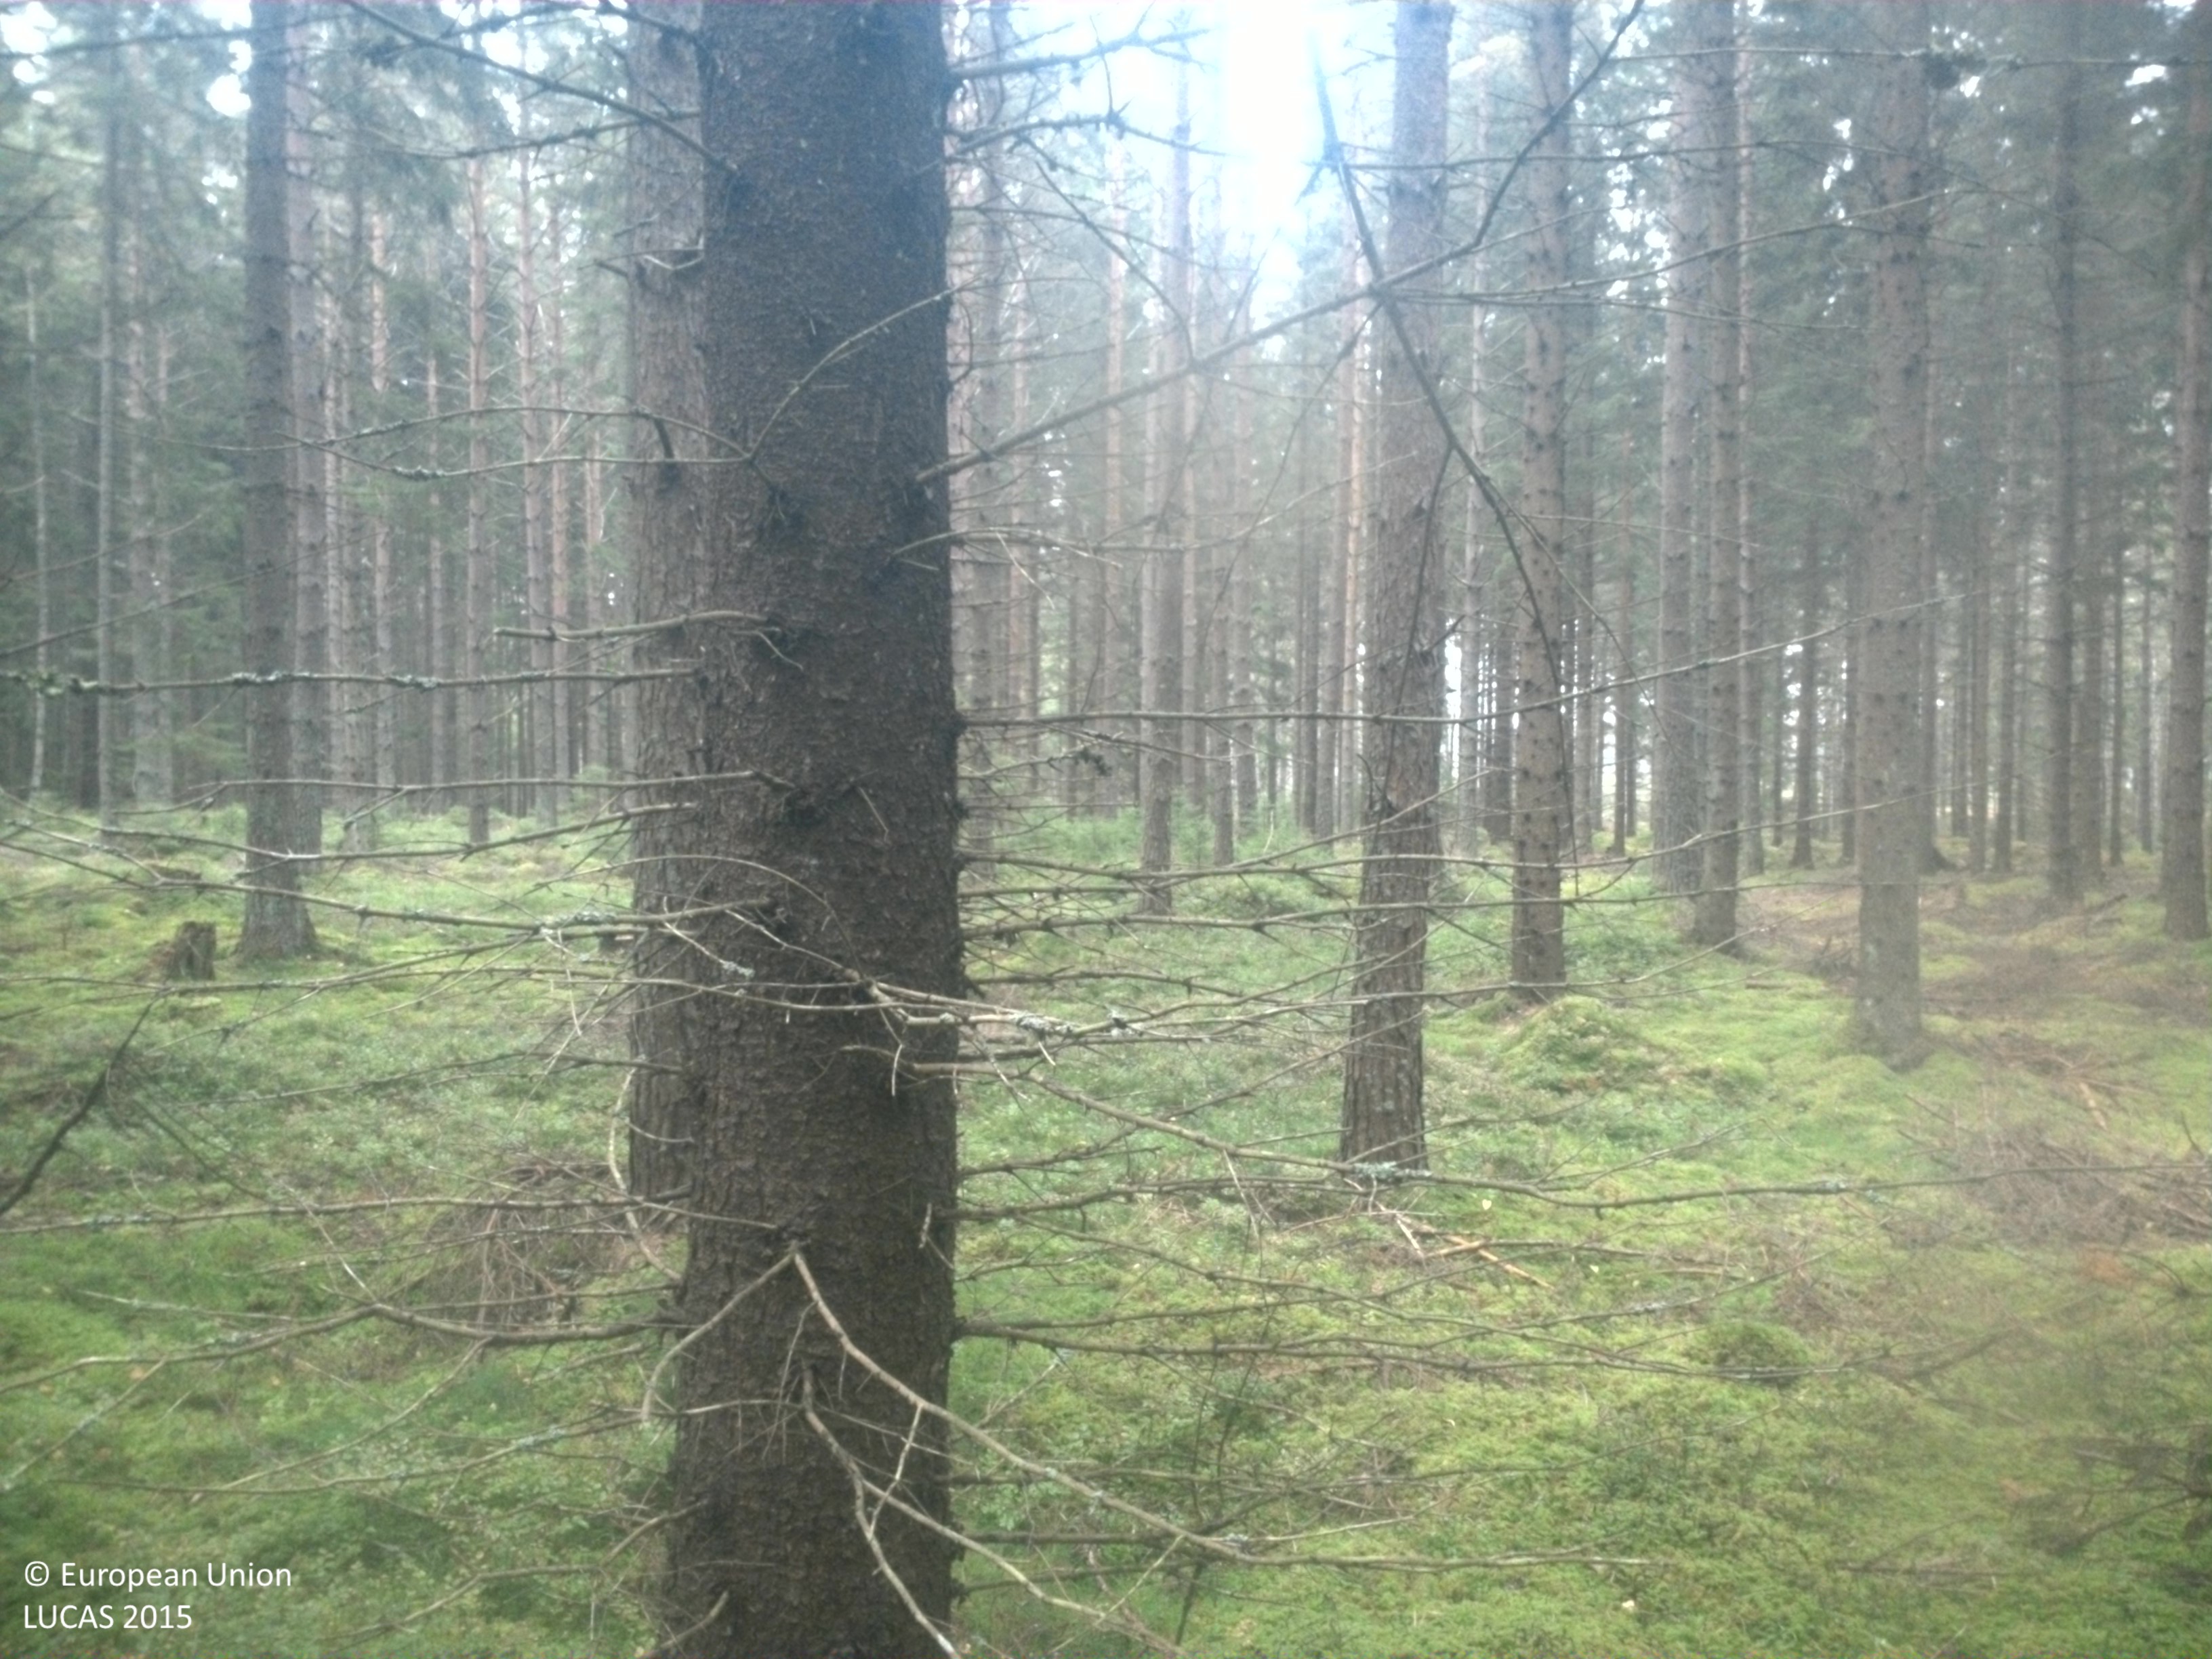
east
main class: Woodland
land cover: Spruce dominated coniferous woodland
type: boreal forest
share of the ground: 50 - 75 %
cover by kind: coniferous forest trees 60 %, lichens and mosses 25 %, shrubs 15 %
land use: Forestry
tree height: > 5 m
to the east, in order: Spruce dominated coniferous woodland; Pine dominated coniferous woodland; Pine dominated mixed woodland; Spruce dominated coniferous woodland; Ditches and canals; Paved roads, cycling and walking lanes; Spruce dominated coniferous woodland
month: September
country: SE
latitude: 58.7718
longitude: 14.0223
